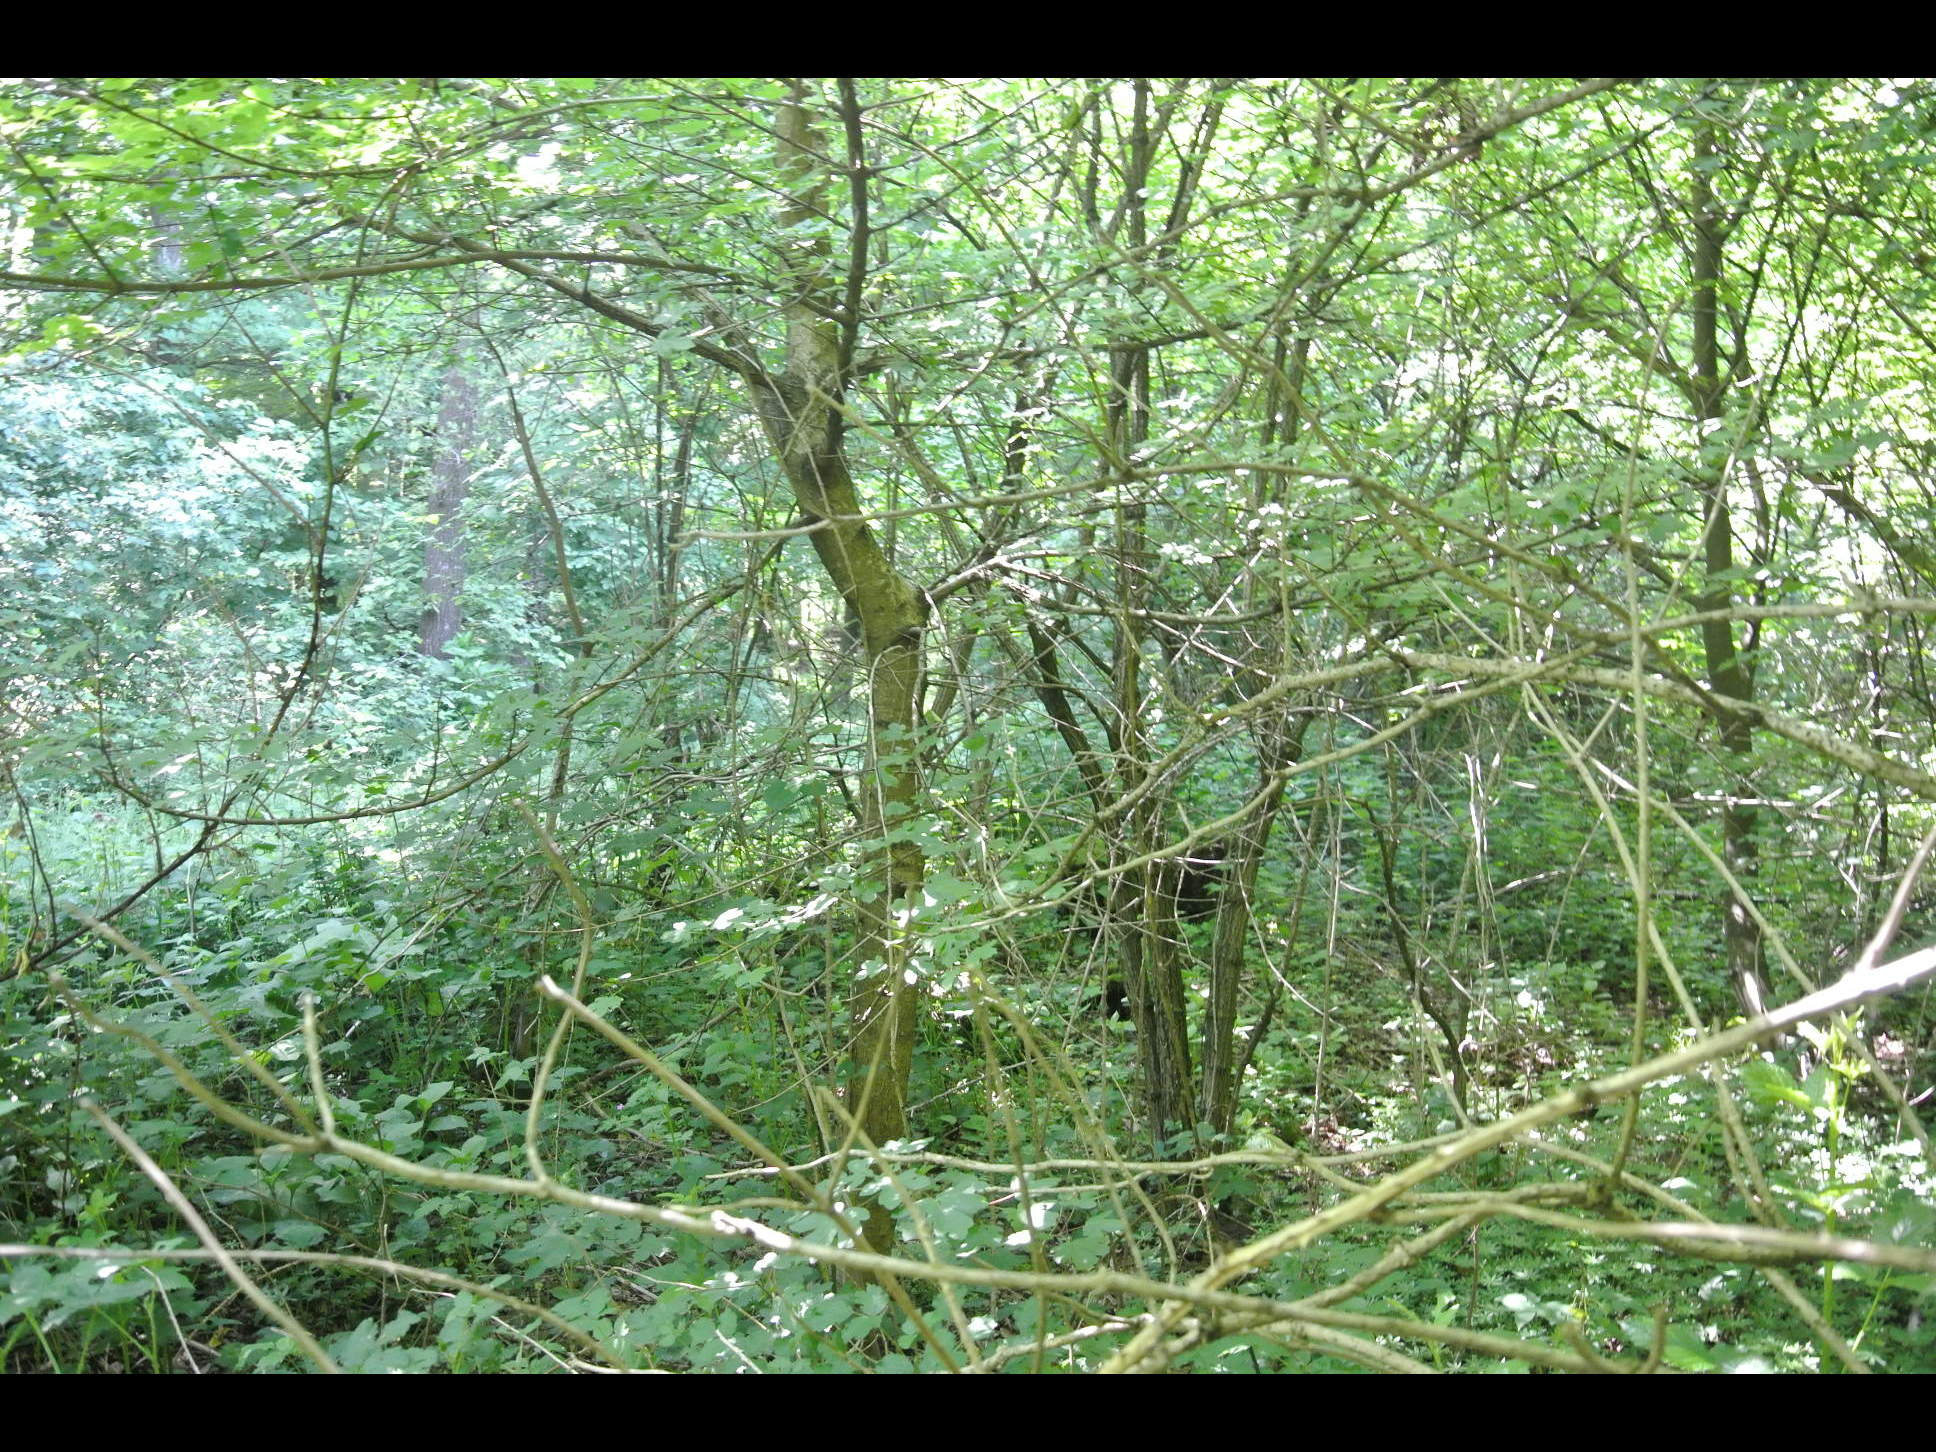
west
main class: Woodland
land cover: Broadleaved woodland
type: mesophytic deciduous forest
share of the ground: > 75 %
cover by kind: broadleaved forest trees 90 %, shrubs 10 %
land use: Forestry
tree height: > 5 m
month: May
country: AT
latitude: 47.9515
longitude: 16.6335
